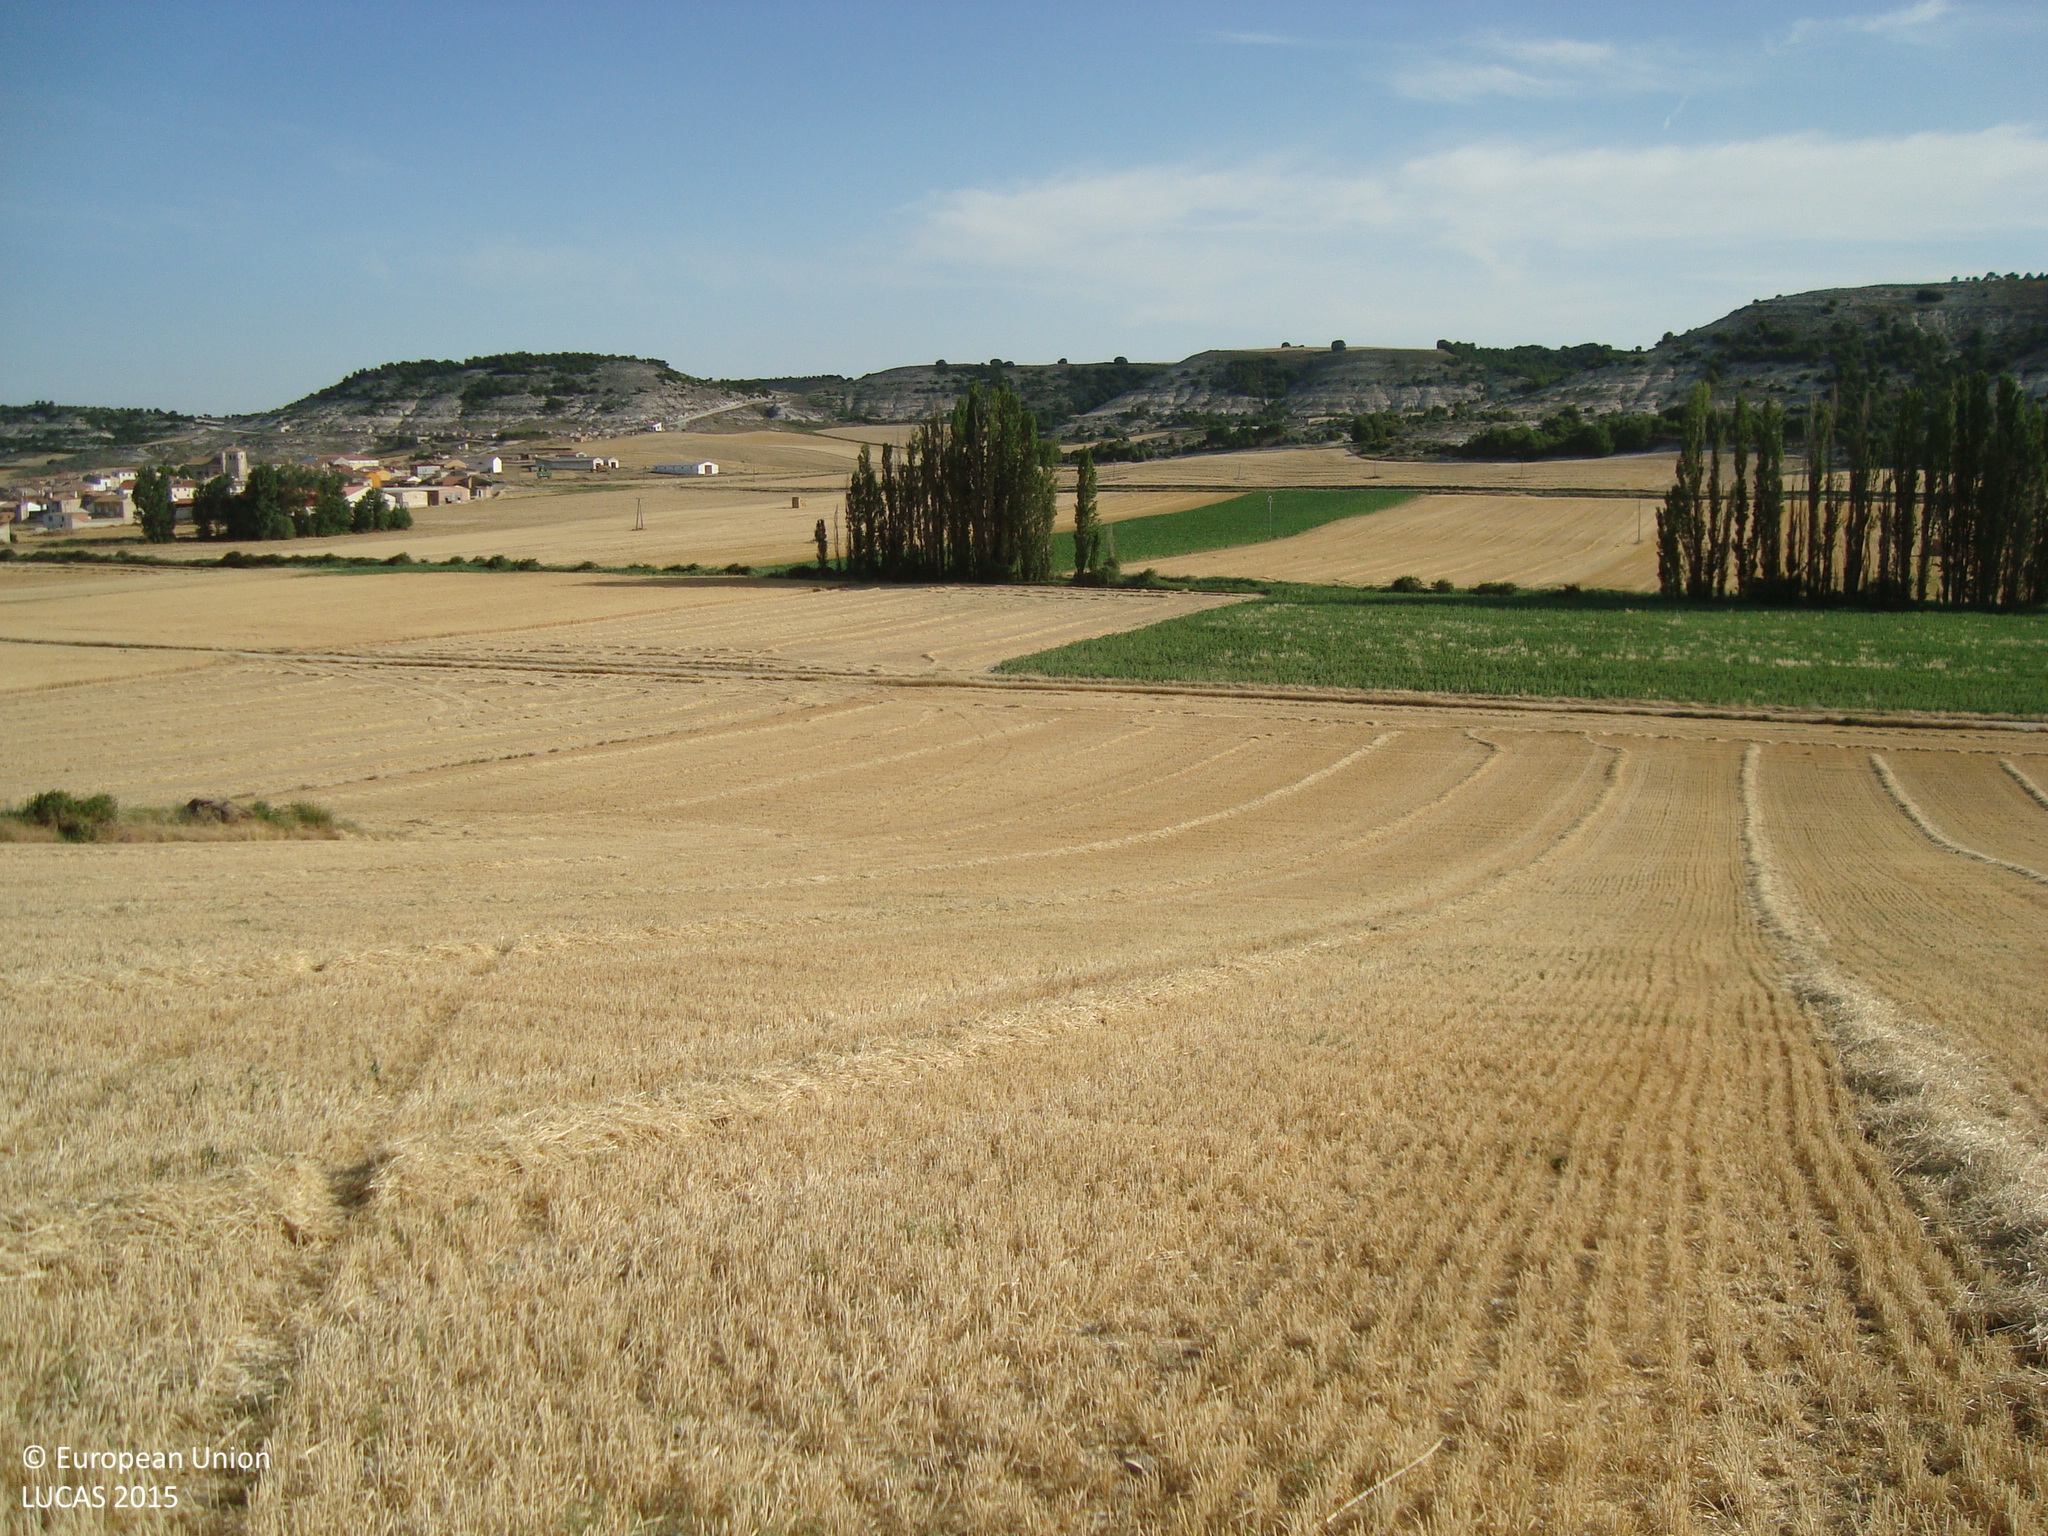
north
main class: Cropland
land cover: Barley
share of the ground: > 75 %
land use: Agriculture (excluding fallow land and kitchen gardens)
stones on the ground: 10 - 25 %
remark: Harvested field
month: July
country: ES
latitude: 41.8648
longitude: -4.2188
